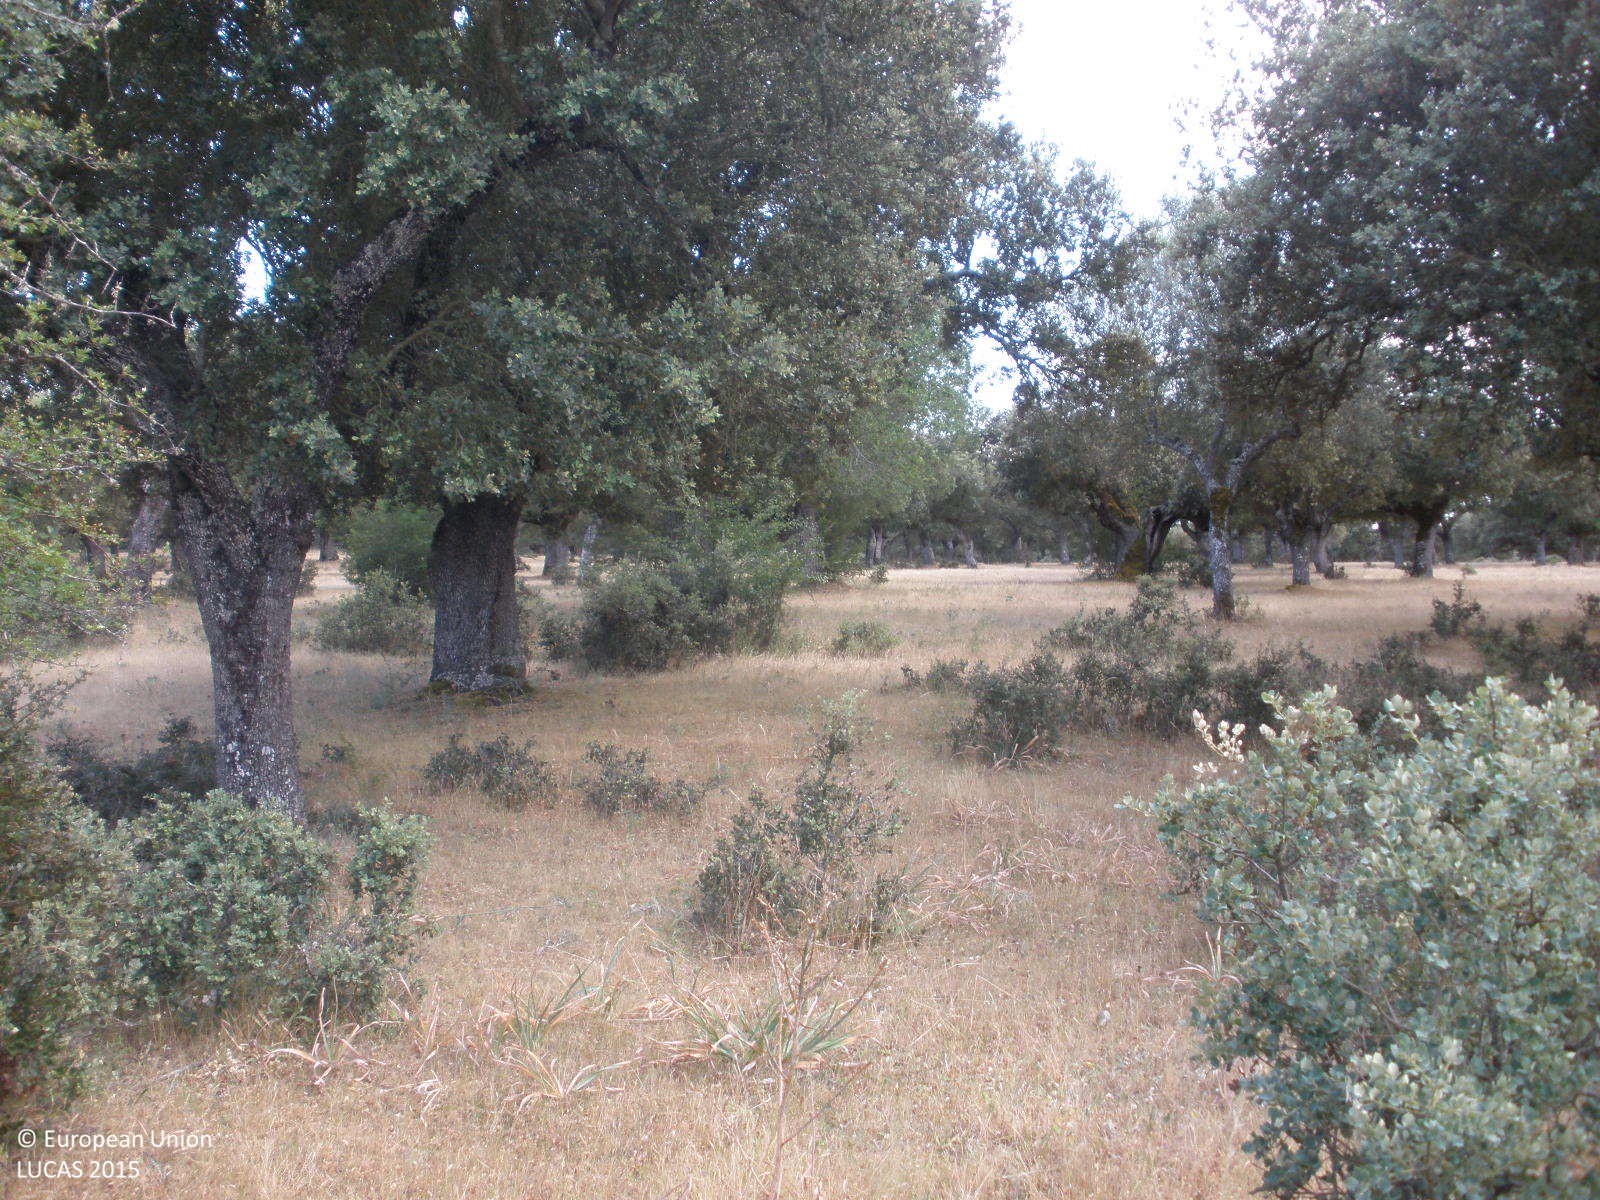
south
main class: Woodland
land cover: Broadleaved woodland
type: broadleaved evergreen forest
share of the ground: > 75 %
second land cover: Grassland without tree/shrub cover
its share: > 75 %
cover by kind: broadleaved forest trees 60 %, herbaceous plants 30 %, shrubs 10 %
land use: Forestry
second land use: Agriculture (excluding fallow land and kitchen gardens)
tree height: < 5 m
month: June
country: ES
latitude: 40.7251
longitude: -6.2464
